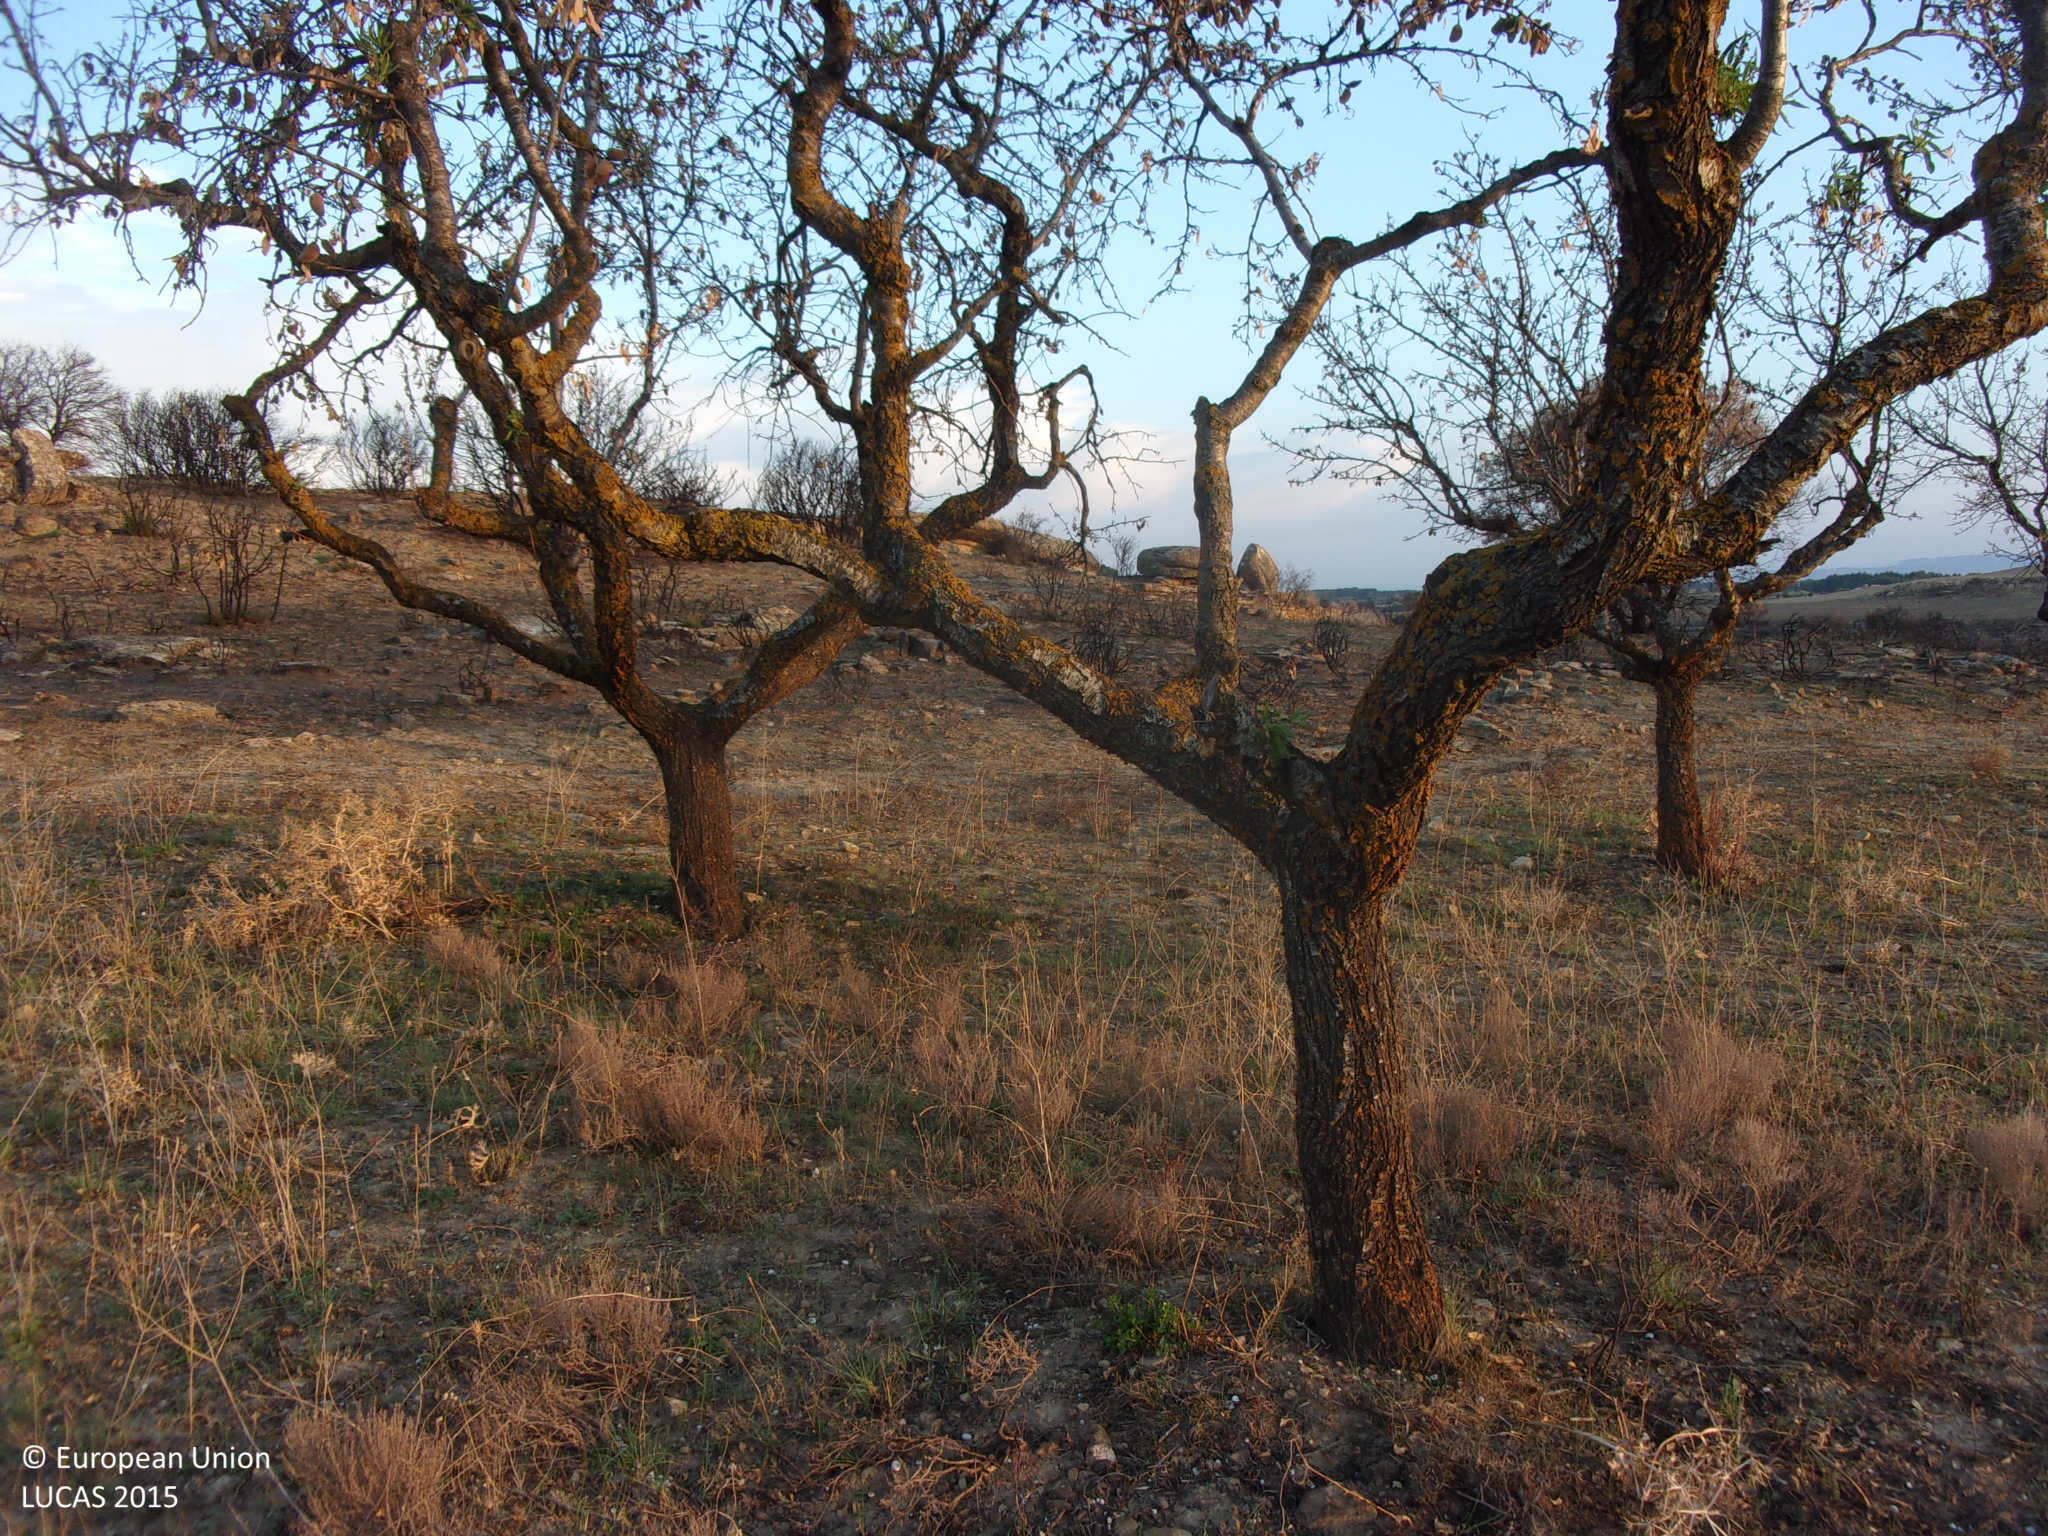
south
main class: Cropland
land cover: Nuts trees
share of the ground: 10 - 25 %
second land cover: Spontaneously vegetated surfaces
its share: > 75 %
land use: Agriculture (excluding fallow land and kitchen gardens)
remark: Burnt area
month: August
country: ES
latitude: 42.2529
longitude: -1.1687
